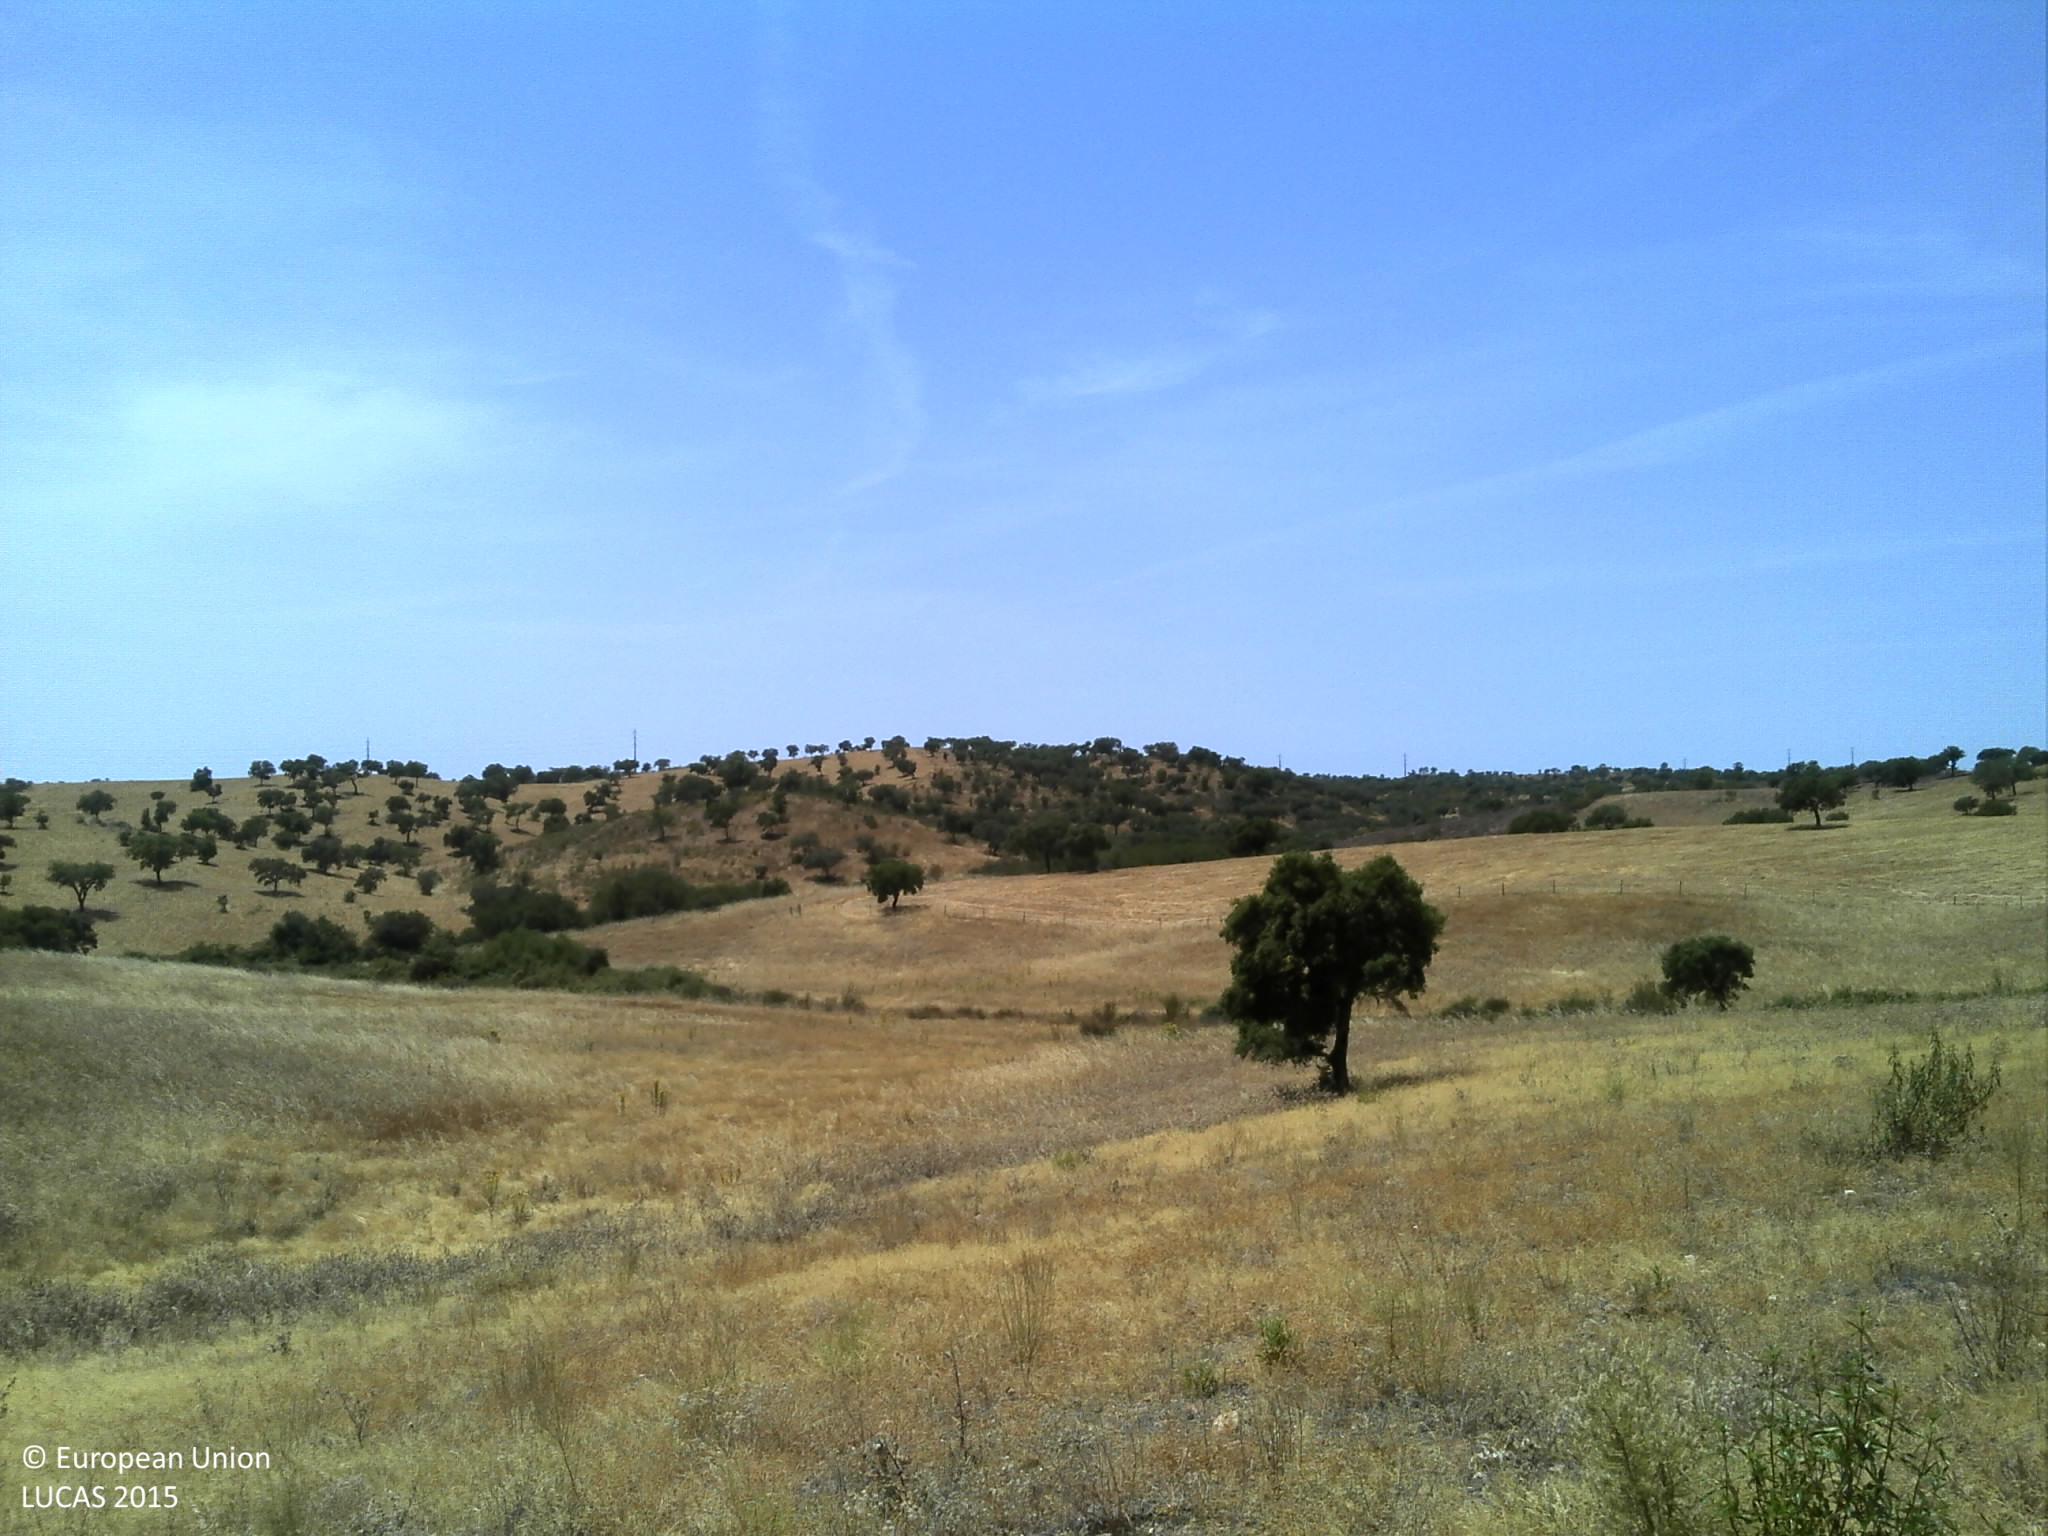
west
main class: Grassland
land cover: Grassland without tree/shrub cover
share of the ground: 25 - 50 %
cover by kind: unconsolidated bare surface 75 %, herbaceous plants 25 %
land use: Agriculture (excluding fallow land and kitchen gardens)
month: July
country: PT
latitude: 38.2842
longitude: -7.6450
